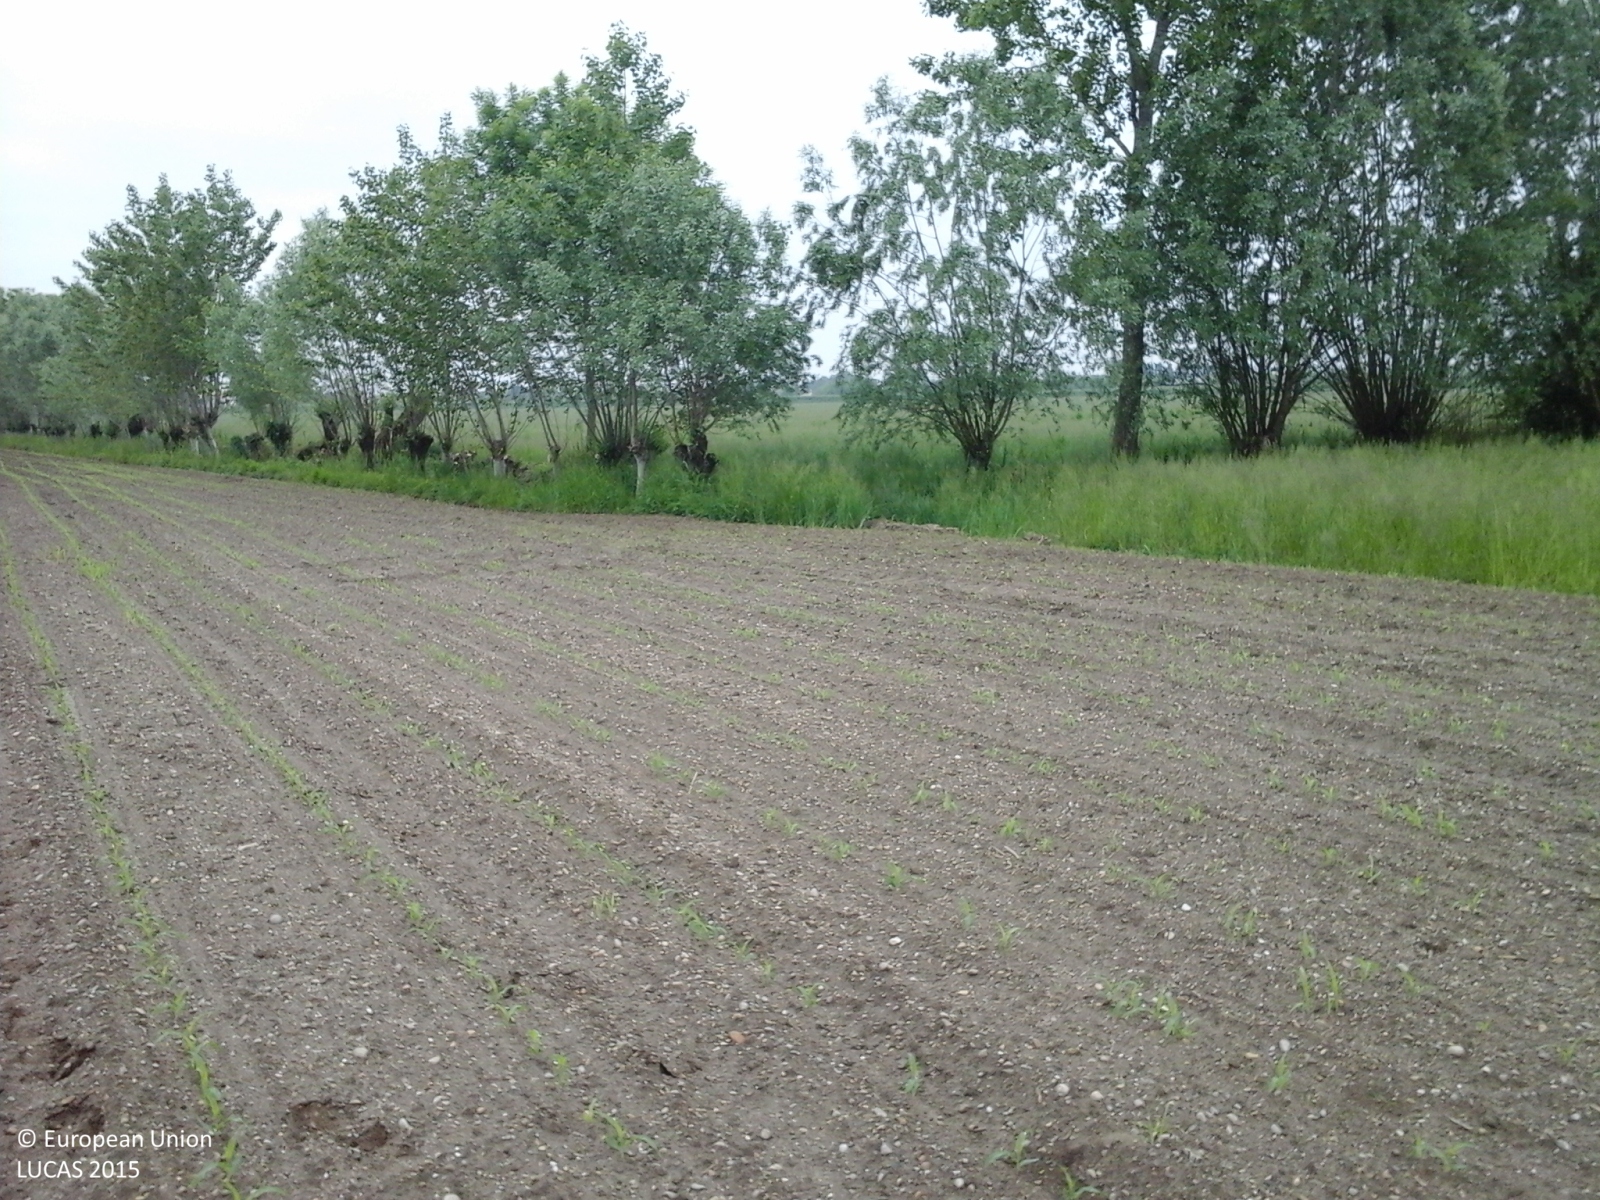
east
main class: Cropland
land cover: Maize
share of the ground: < 10 %
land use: Agriculture (excluding fallow land and kitchen gardens)
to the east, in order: Maize; Managed hedges; Ditches and canals; Managed hedges; Grassland without tree/shrub cover
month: May
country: IT
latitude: 45.5083
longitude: 11.7251
